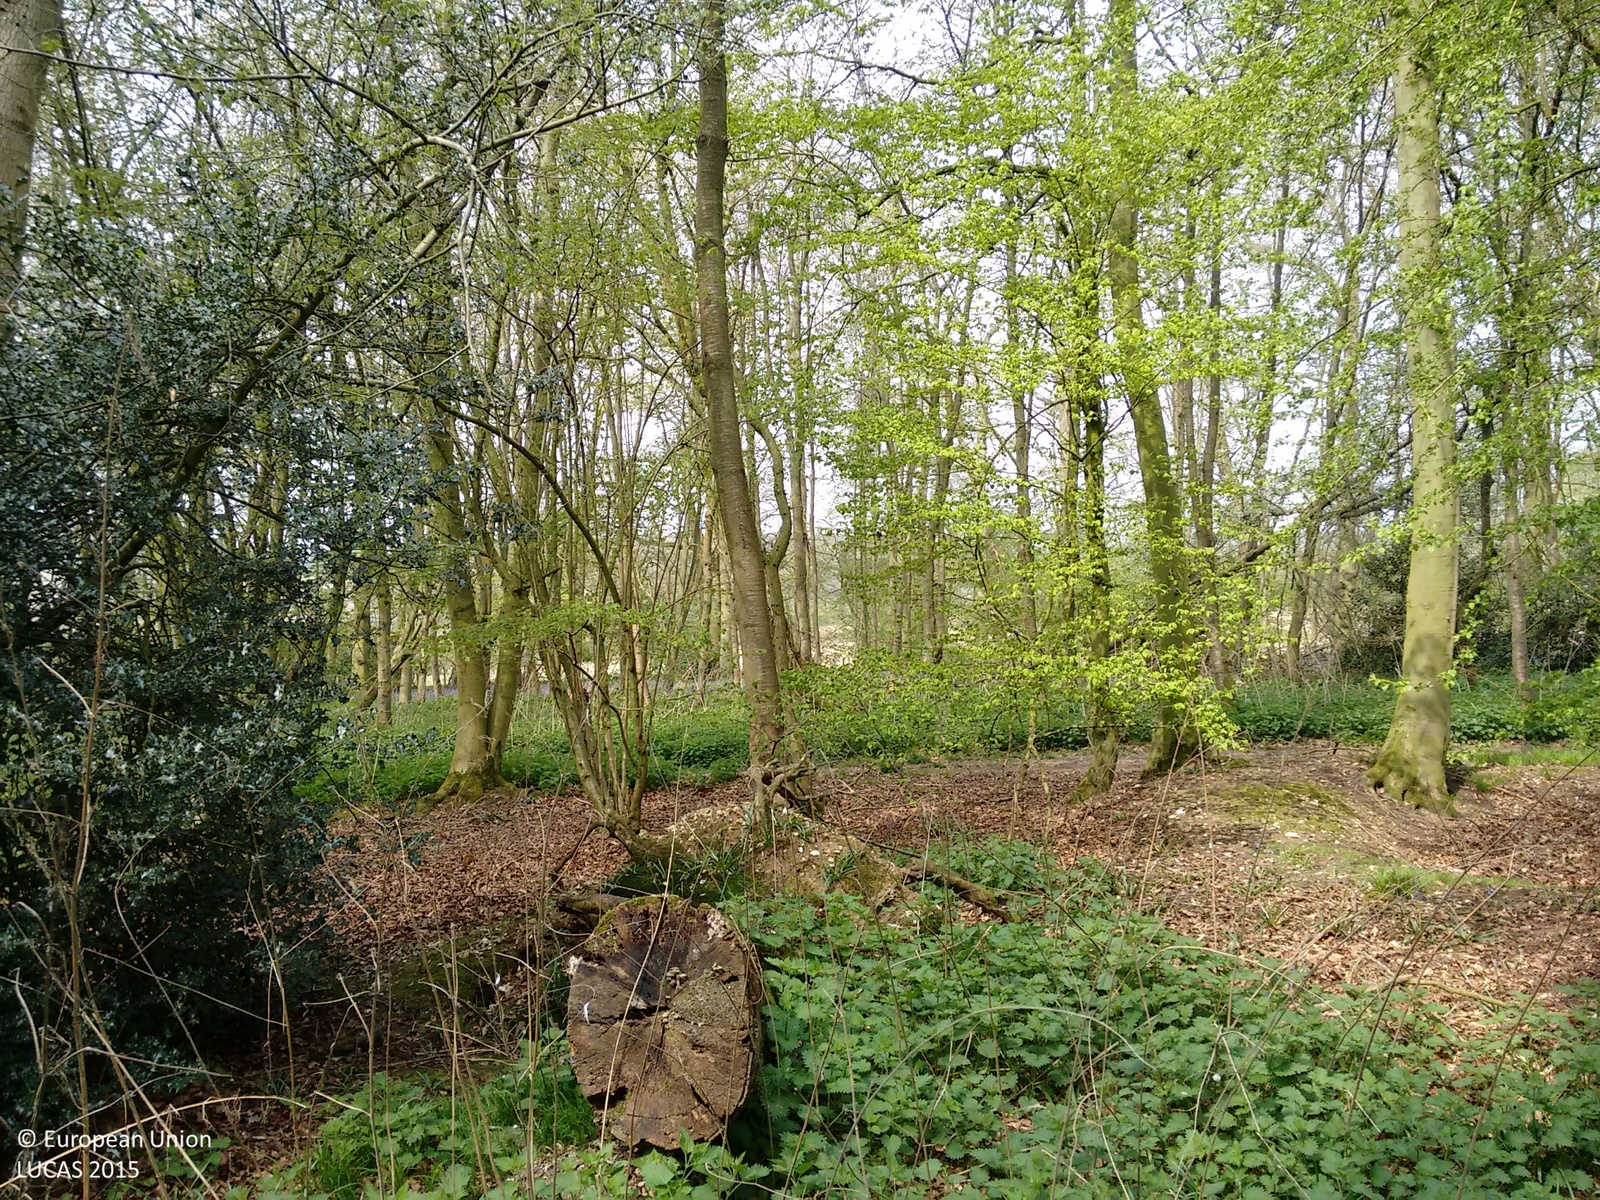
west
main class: Woodland
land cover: Broadleaved woodland
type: mesophytic deciduous forest
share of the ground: > 75 %
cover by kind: broadleaved forest trees 100 %
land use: Forestry
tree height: > 5 m
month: April
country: GB
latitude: 51.7228
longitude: -0.7686
